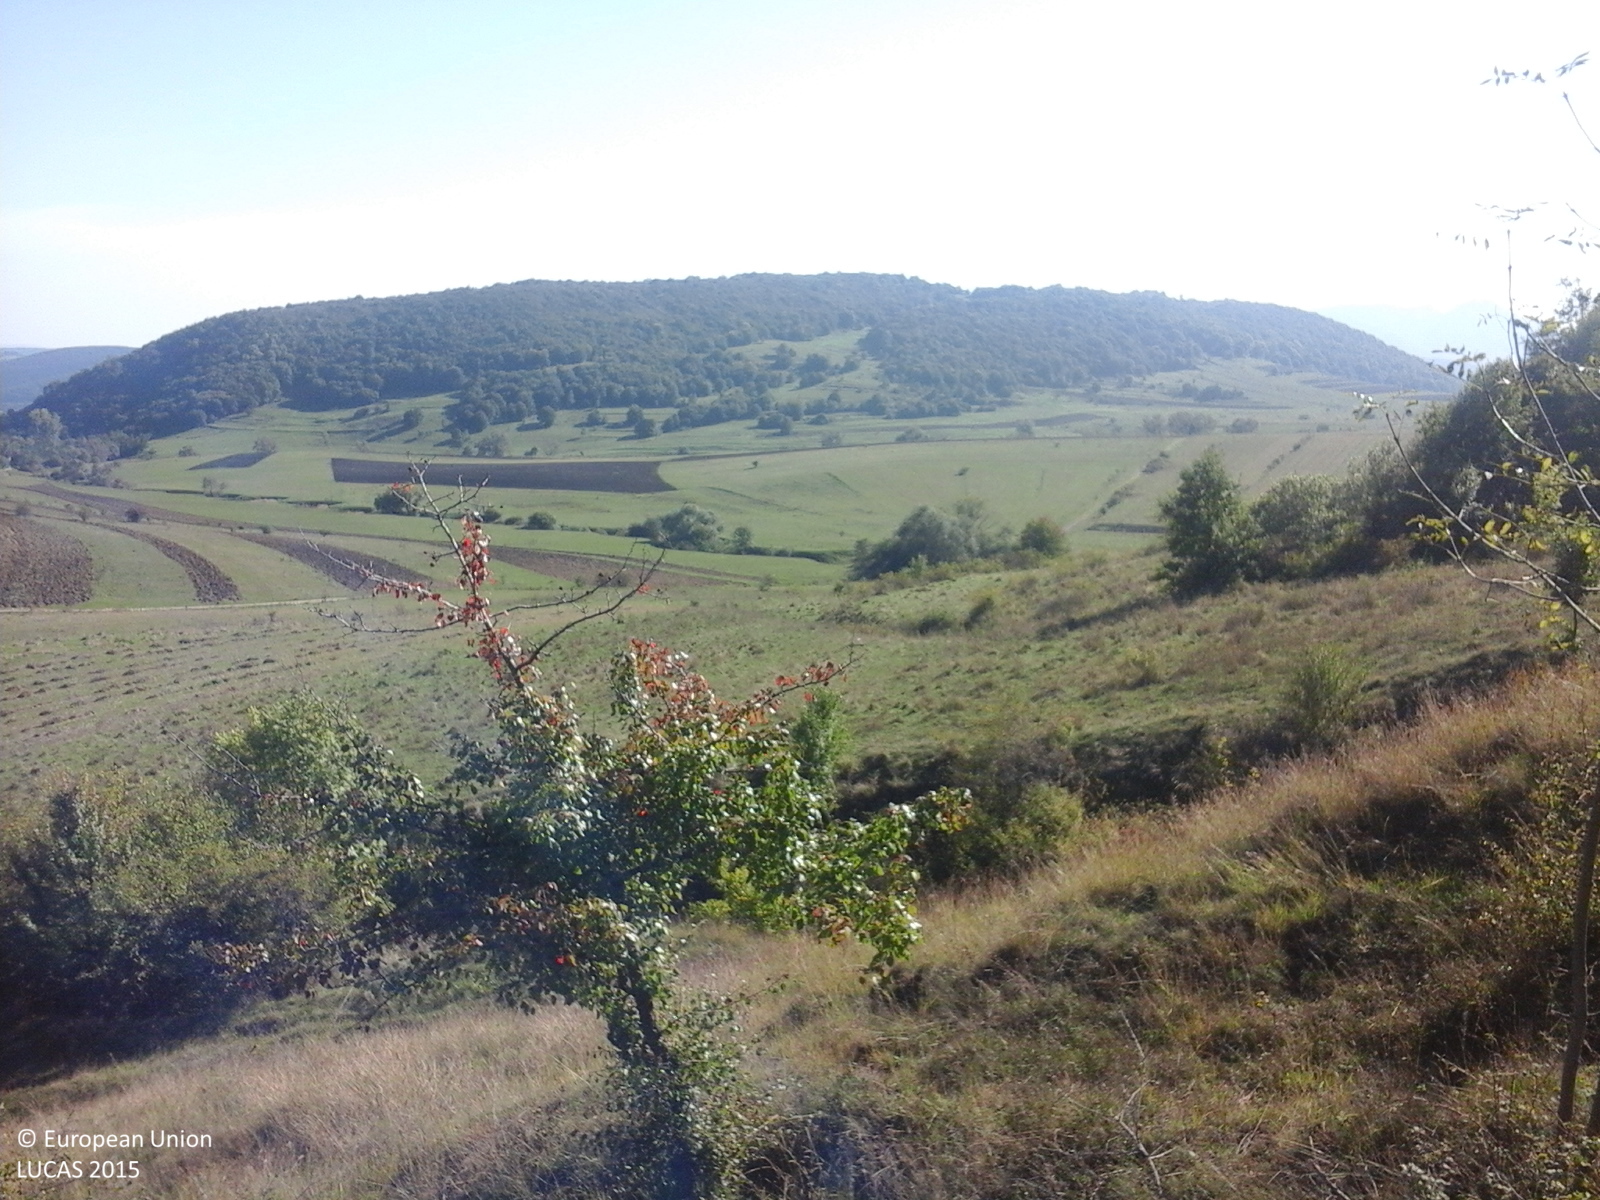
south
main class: Grassland
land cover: Grassland with sparse tree/shrub cover
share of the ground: > 75 %
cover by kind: herbaceous plants 85 %, shrubs 10 %, broadleaved forest trees 5 %
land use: Fallow land
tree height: < 5 m
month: October
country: RO
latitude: 46.5343
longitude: 23.6169
